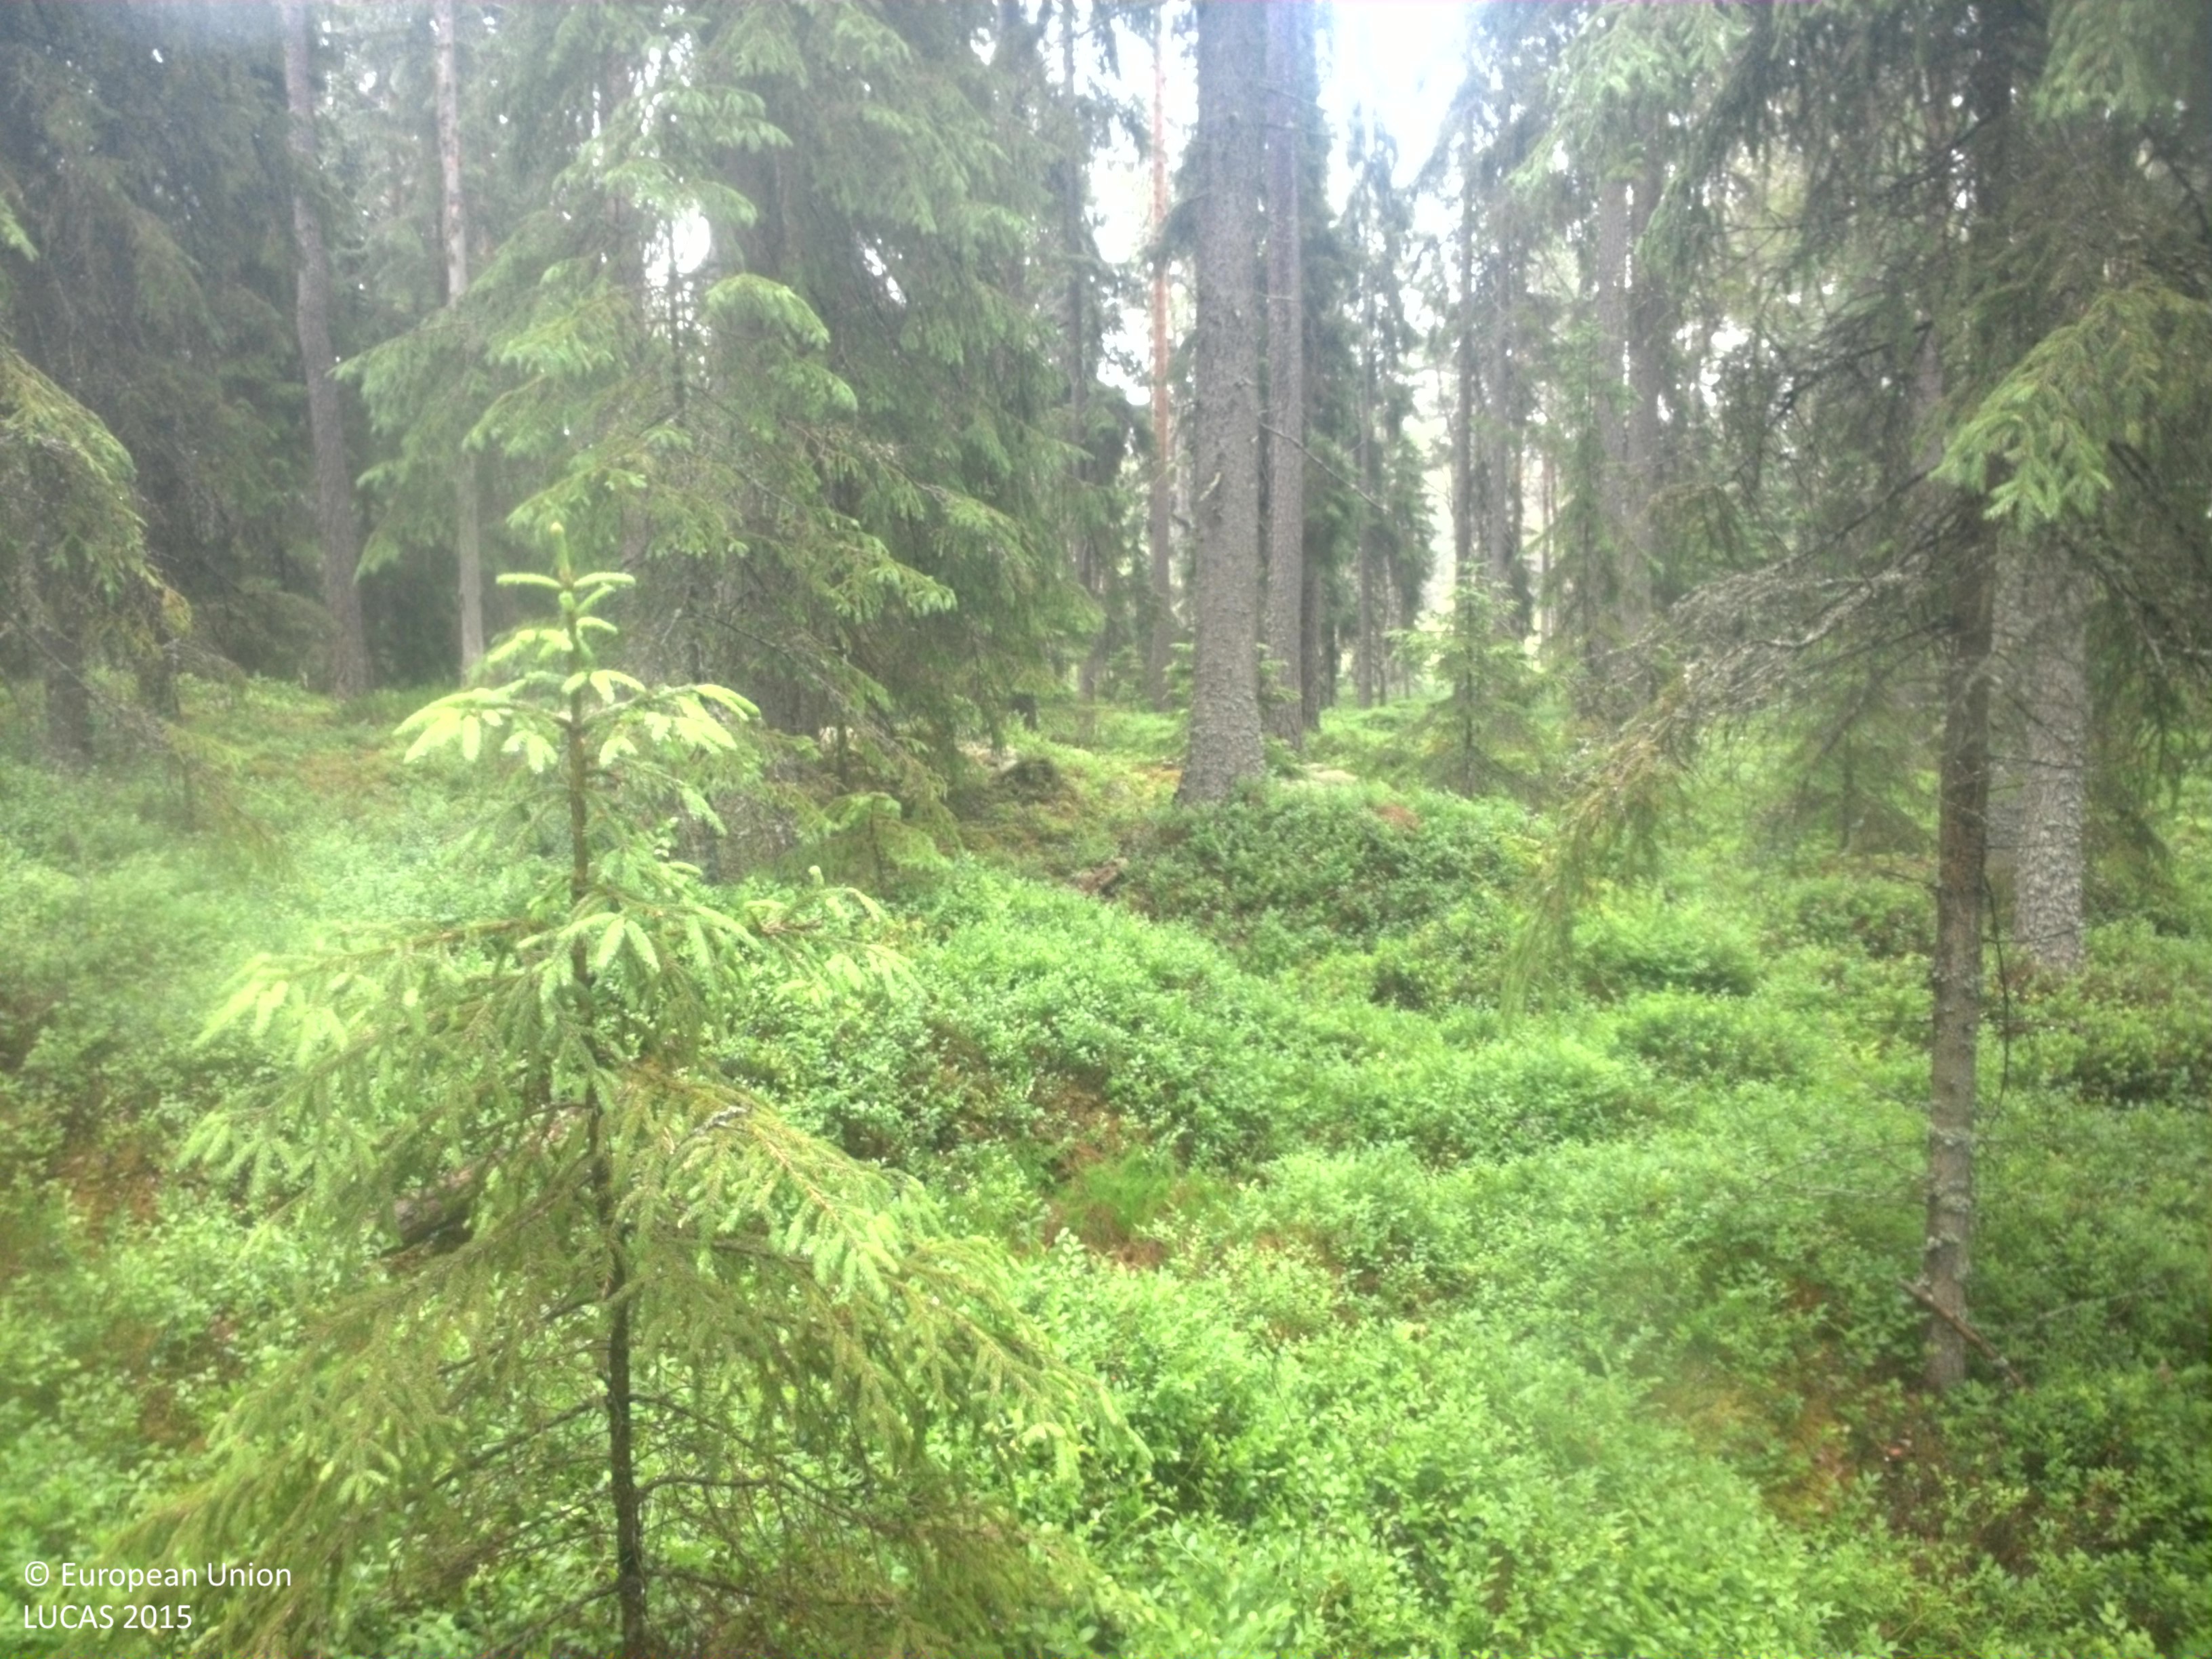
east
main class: Woodland
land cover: Other mixed woodland
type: boreal forest
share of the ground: 50 - 75 %
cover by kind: shrubs 40 %, coniferous forest trees 30 %, broadleaved forest trees 20 %, herbaceous plants 10 %
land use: Forestry
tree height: > 5 m
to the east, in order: Other mixed woodland; Other coniferous woodland; Pine dominated mixed woodland; Ditches and canals; Other mixed woodland; Pine dominated mixed woodland; Spruce dominated coniferous woodland
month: July
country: SE
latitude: 59.3814
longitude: 14.6911
